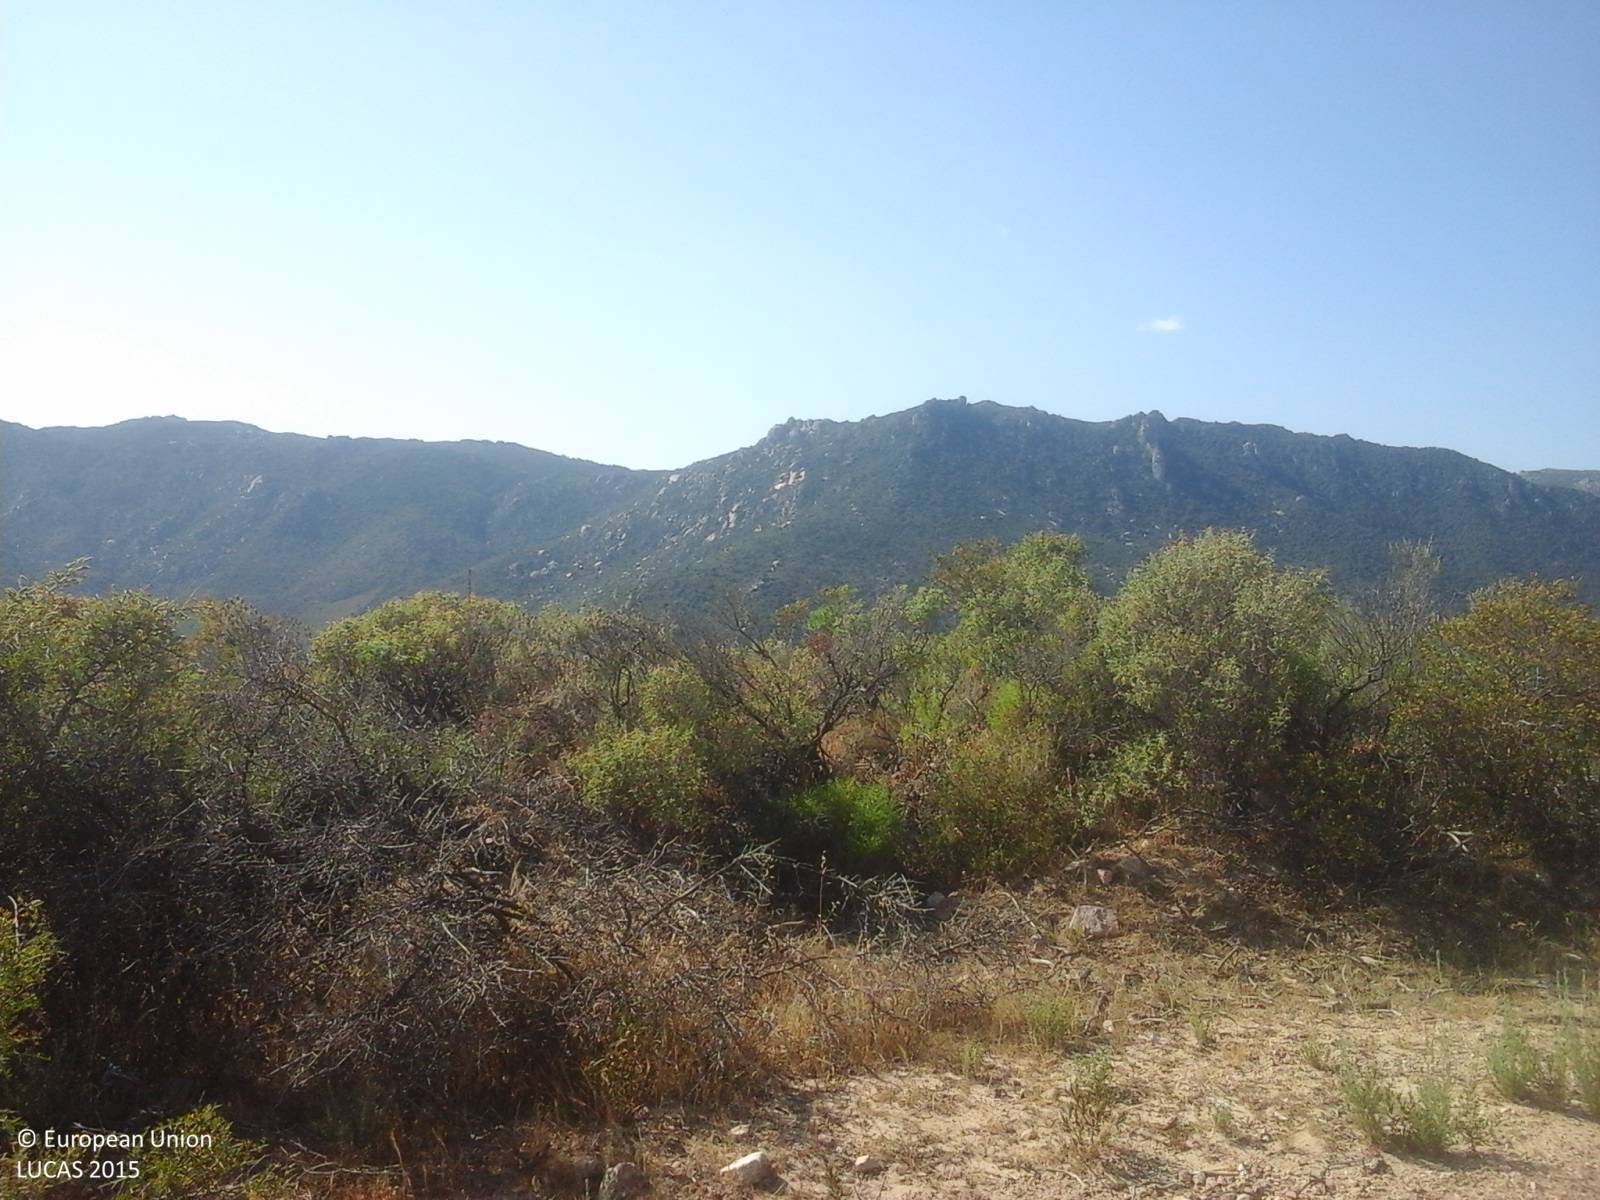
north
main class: Shrubland
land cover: Shrubland without tree cover
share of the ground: > 75 %
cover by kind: shrubs 90 %, herbaceous plants 10 %
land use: Agriculture (excluding fallow land and kitchen gardens)
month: June
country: IT
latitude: 39.2150
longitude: 9.4130
